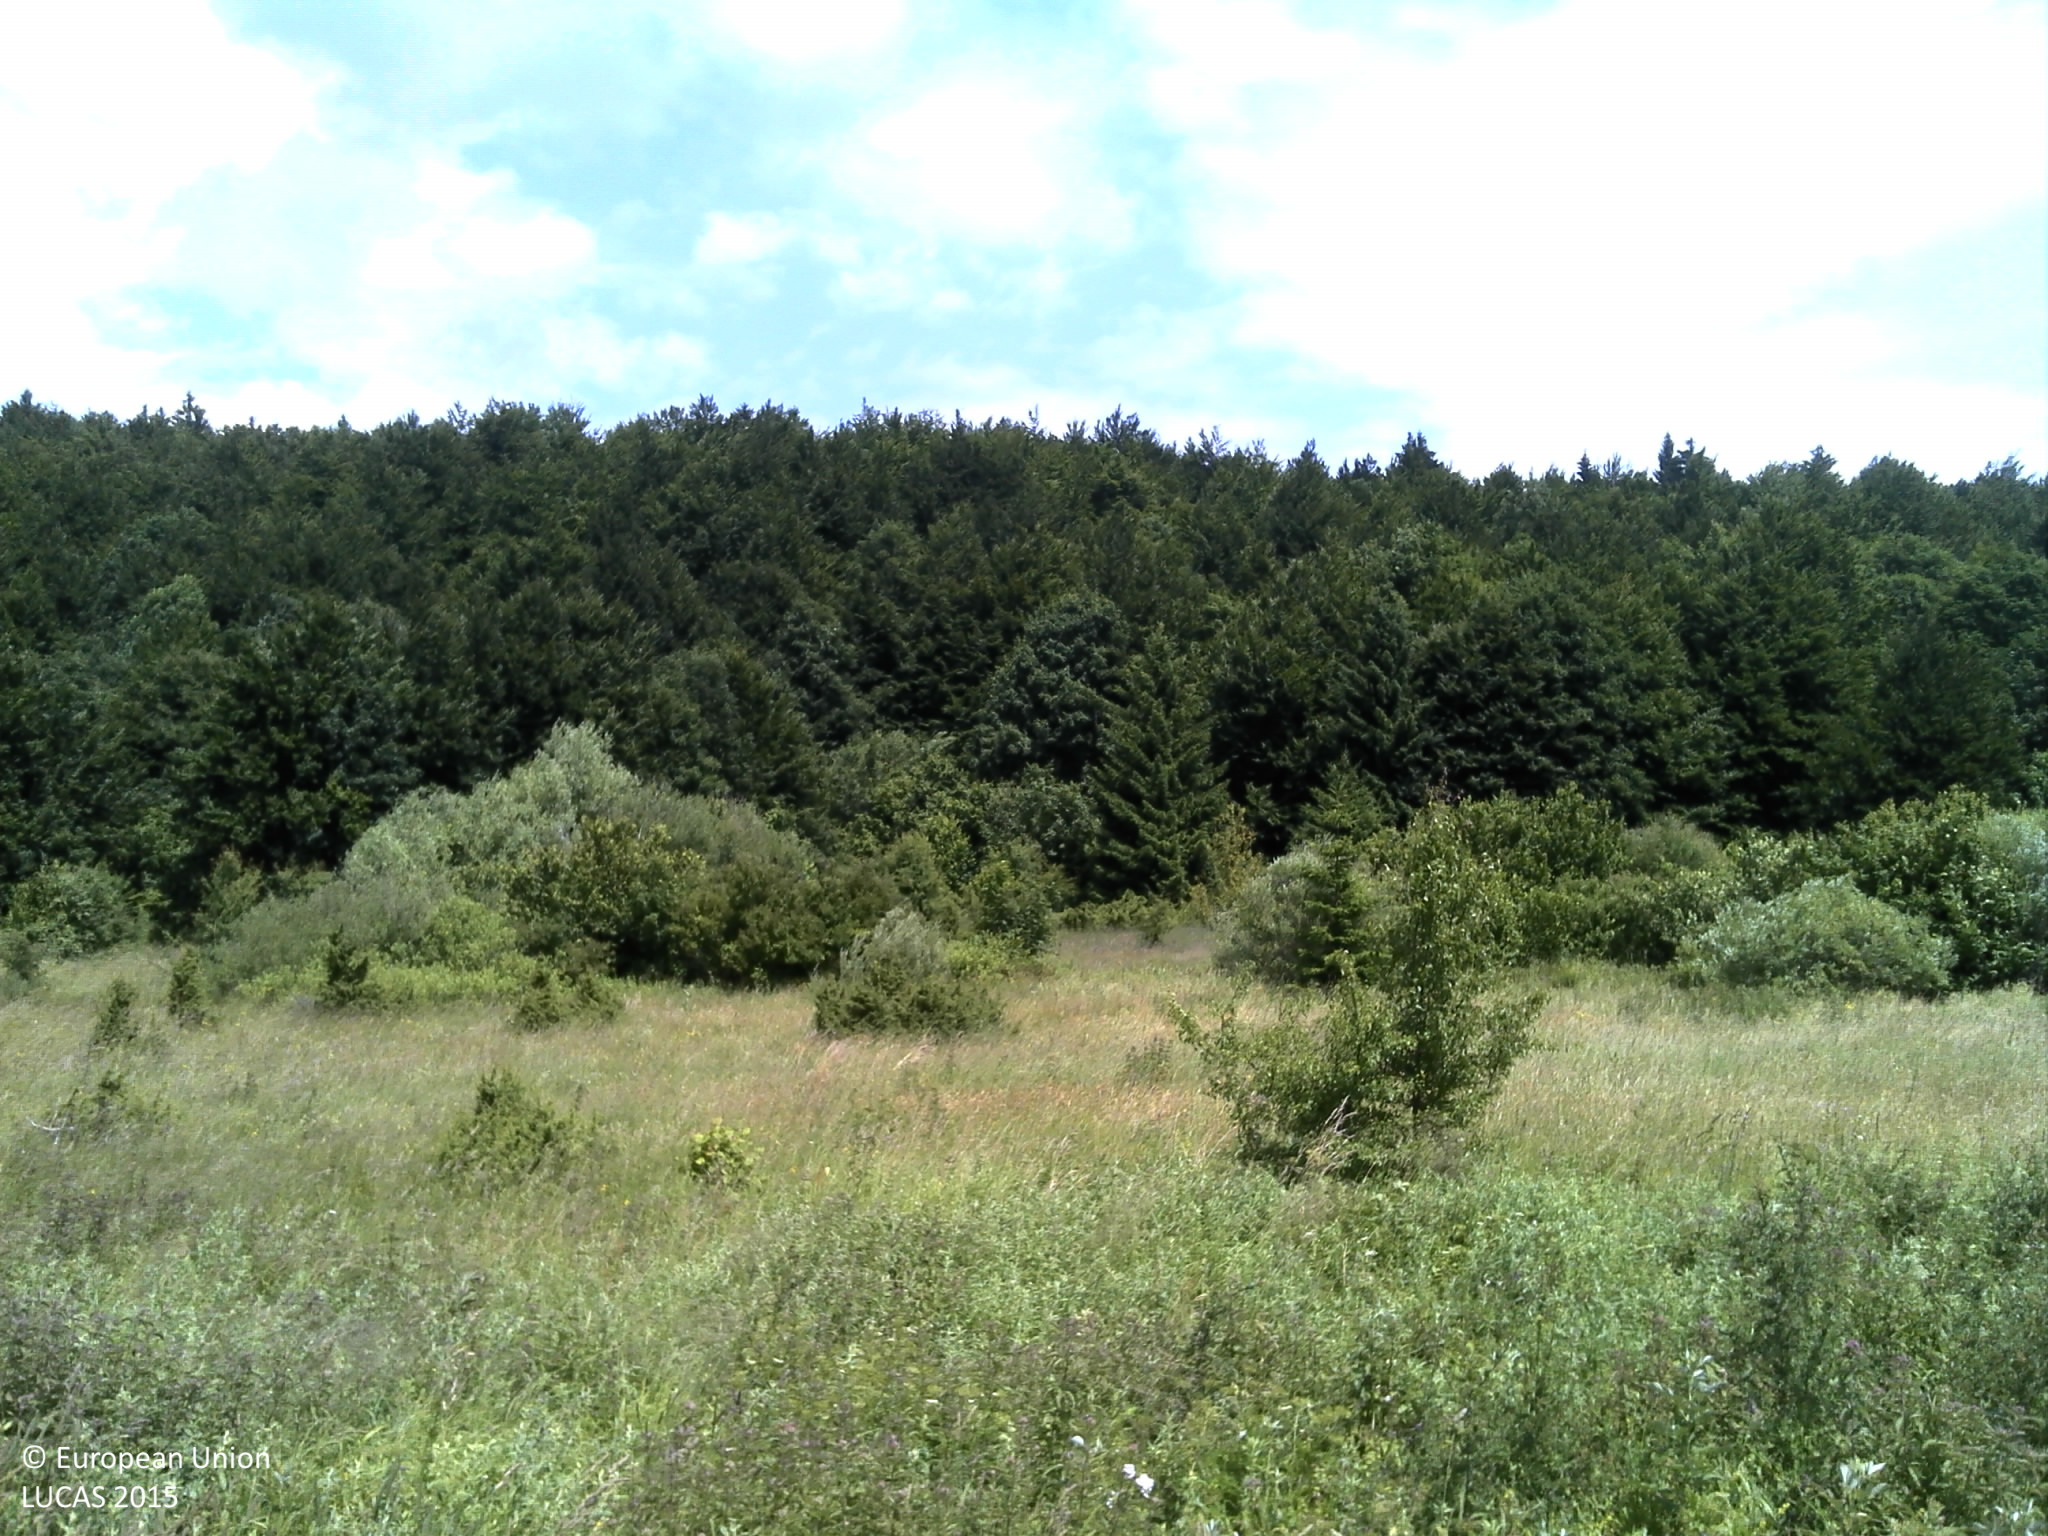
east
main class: Grassland
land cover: Grassland with sparse tree/shrub cover
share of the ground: > 75 %
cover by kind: herbaceous plants 85 %, shrubs 10 %, broadleaved forest trees 5 %
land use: Semi-natural and natural areas not in use
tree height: < 5 m
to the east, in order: Grassland with sparse tree/shrub cover; Electric lines; Grassland with sparse tree/shrub cover; Broadleaved woodland
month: June
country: HR
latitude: 44.8279
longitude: 15.6735
